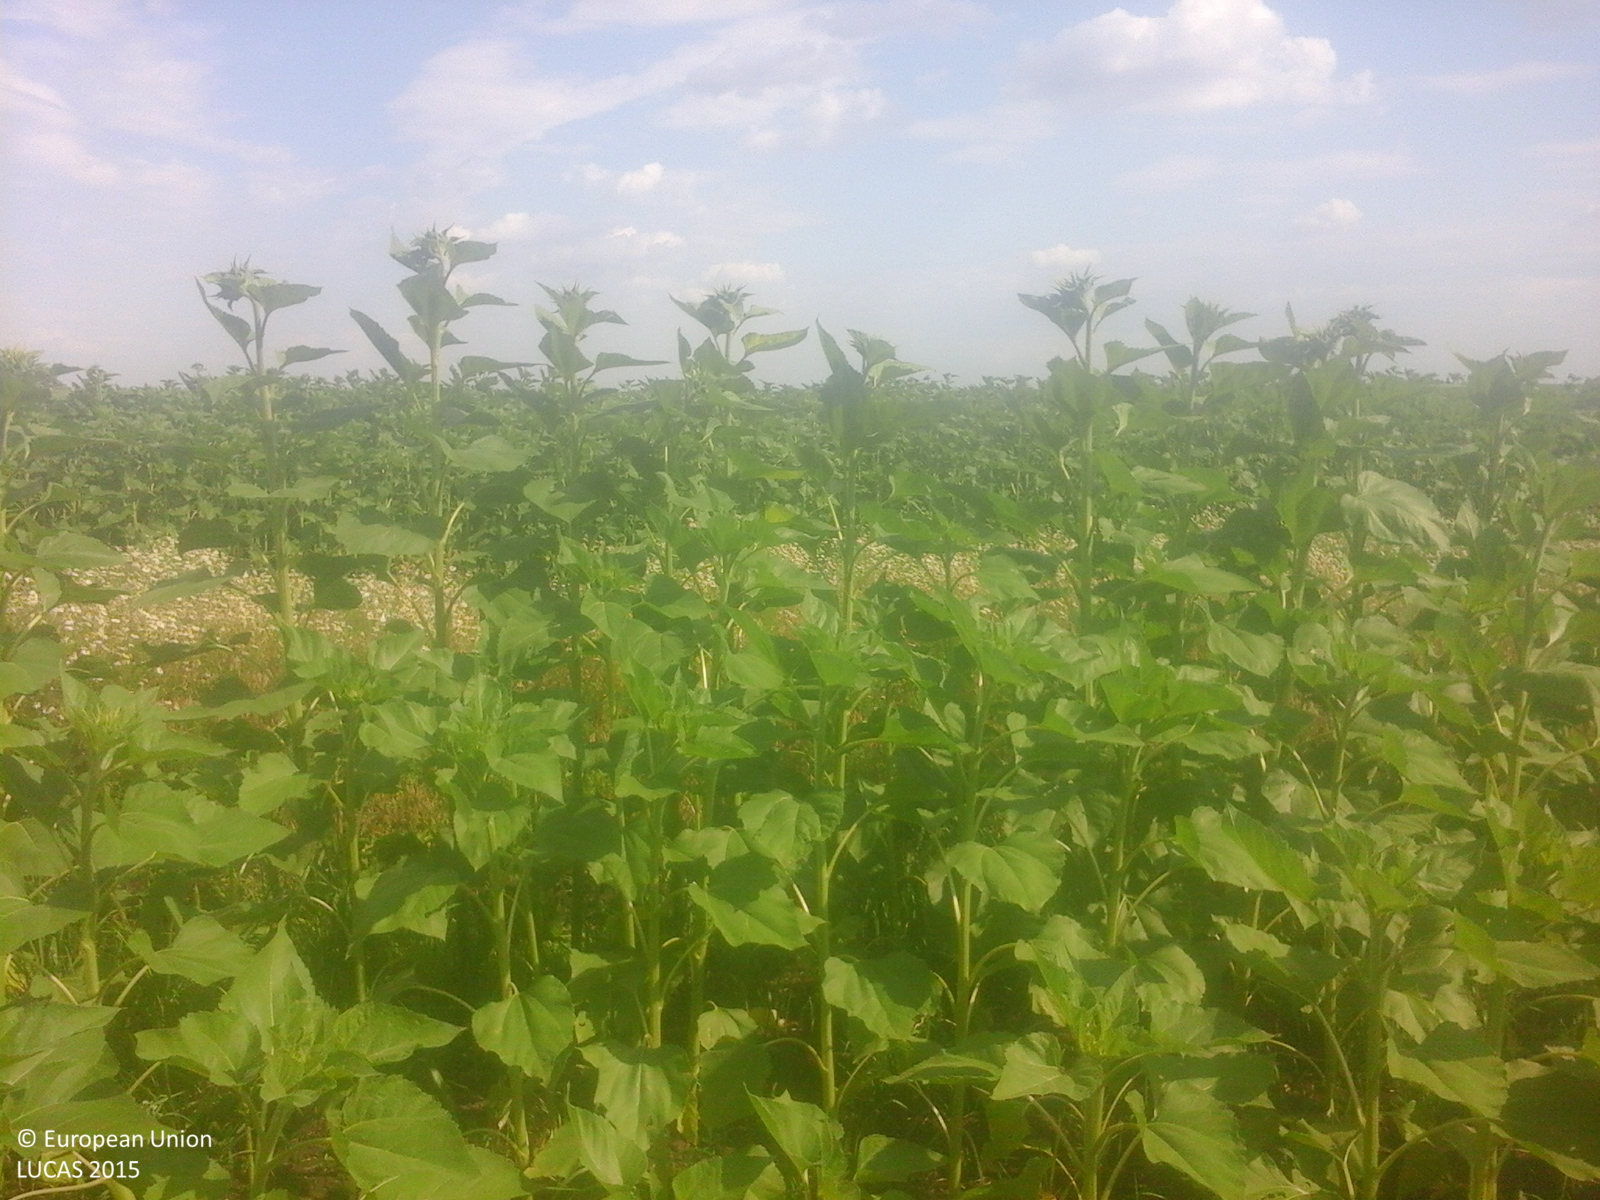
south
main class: Cropland
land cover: Sunflower
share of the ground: > 75 %
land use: Agriculture (excluding fallow land and kitchen gardens)
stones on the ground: < 10 %
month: July
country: RO
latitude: 44.0822
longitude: 25.4596
